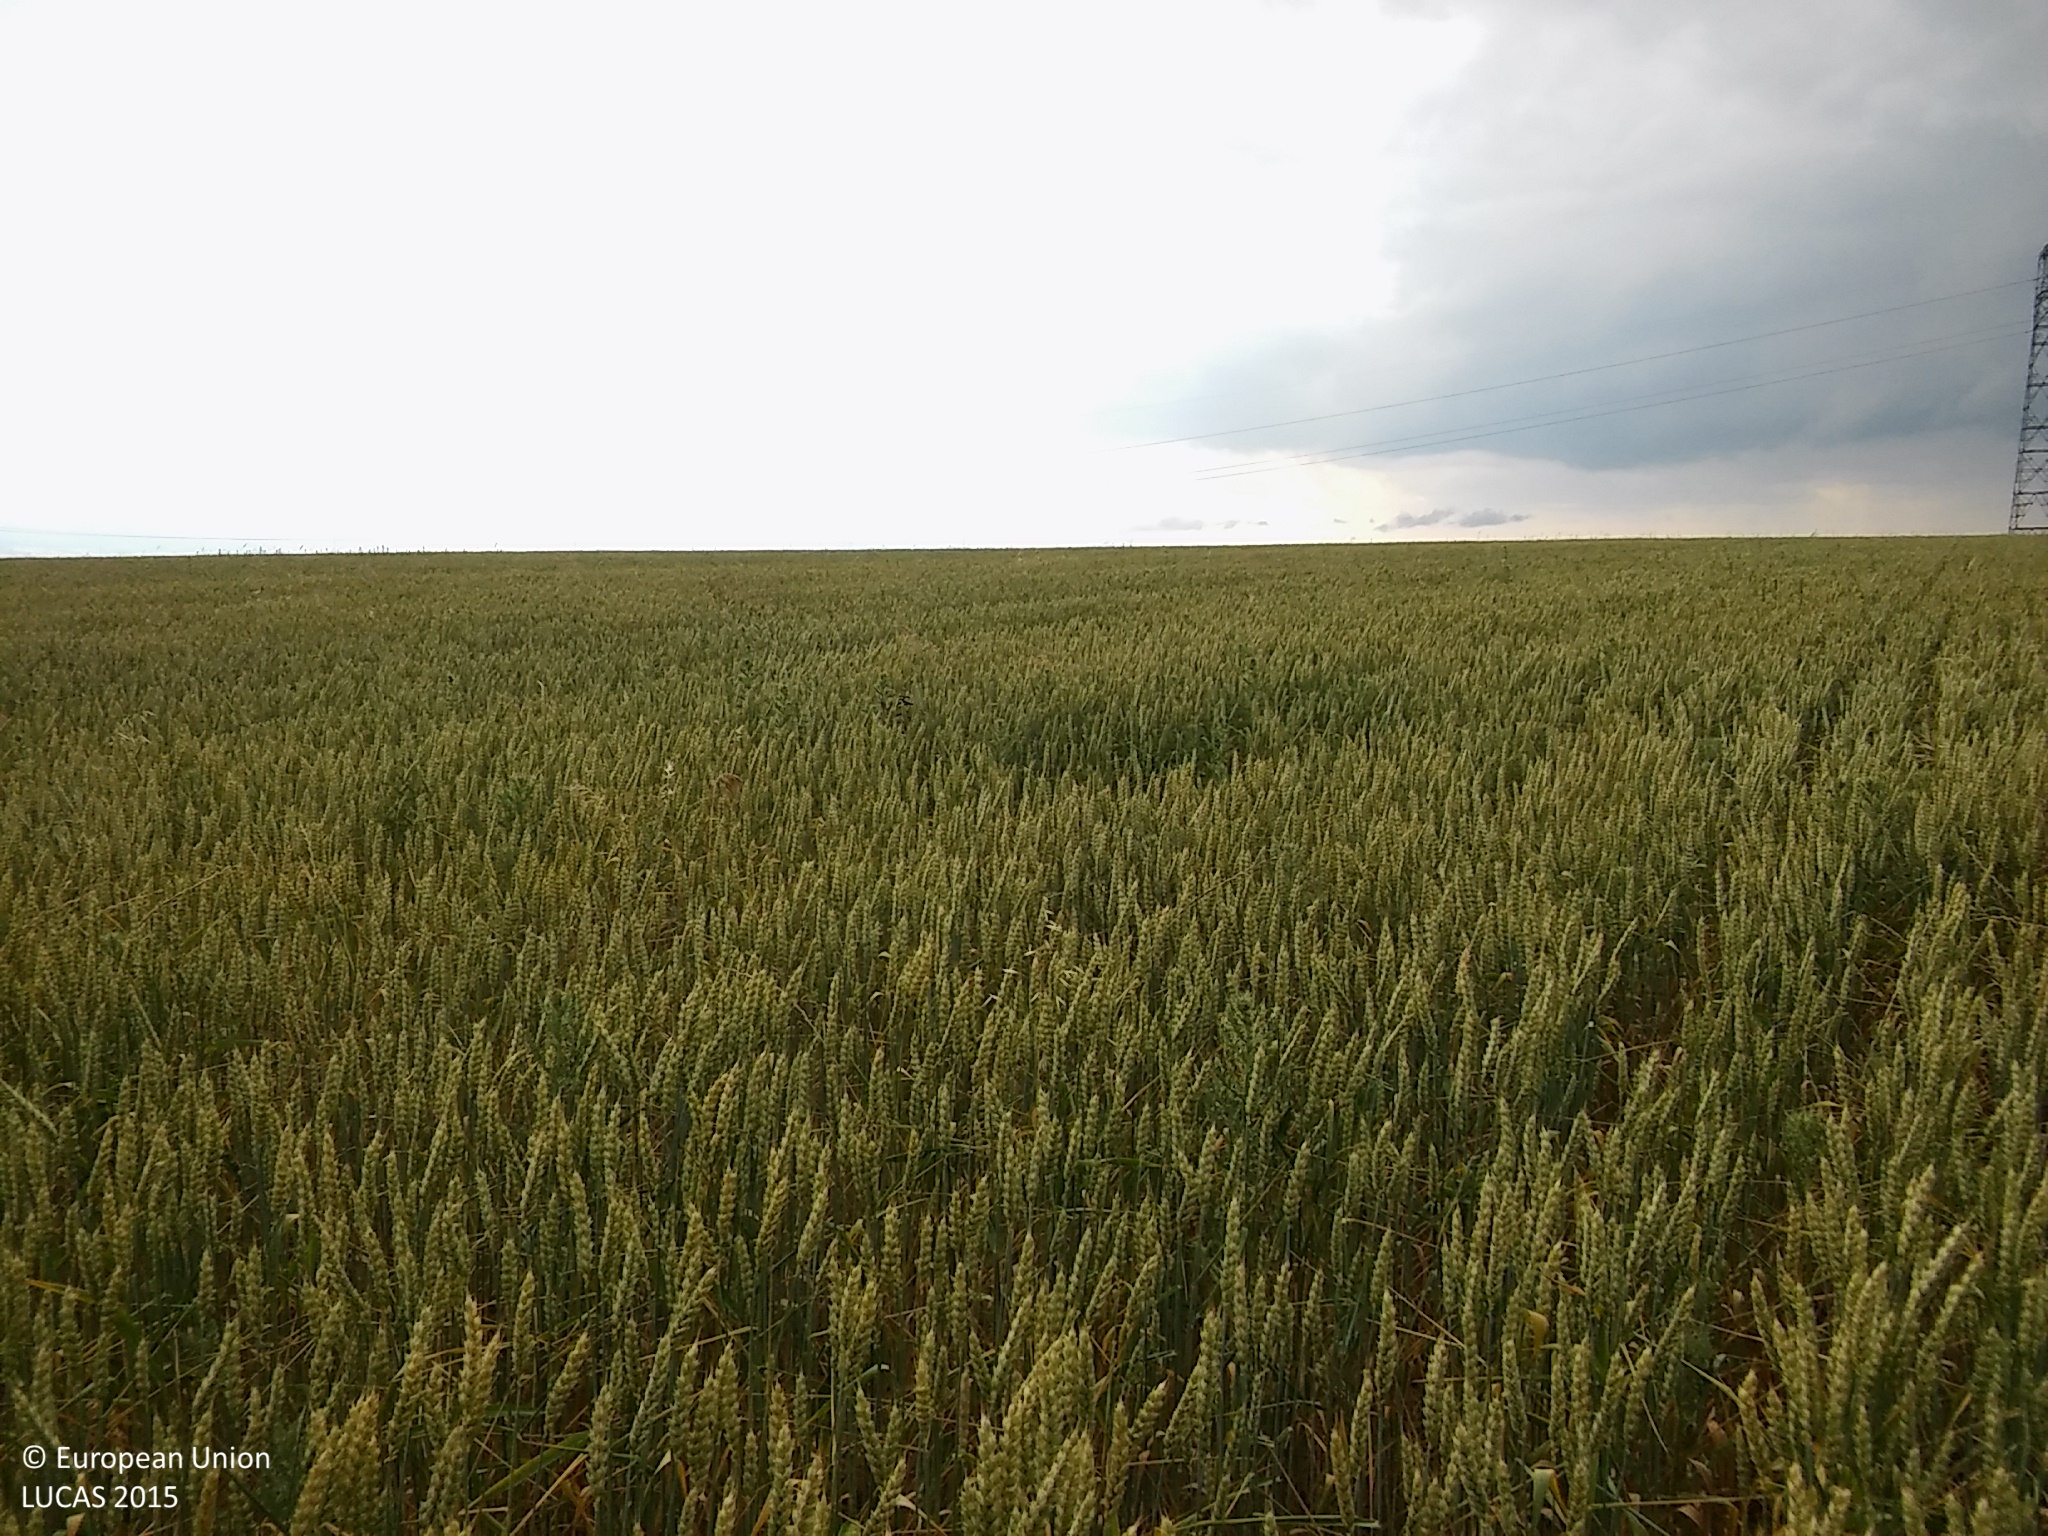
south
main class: Cropland
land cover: Common wheat
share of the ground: > 75 %
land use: Agriculture (excluding fallow land and kitchen gardens)
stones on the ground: 25 - 50 %
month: June
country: ES
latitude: 41.2475
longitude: -3.6632
